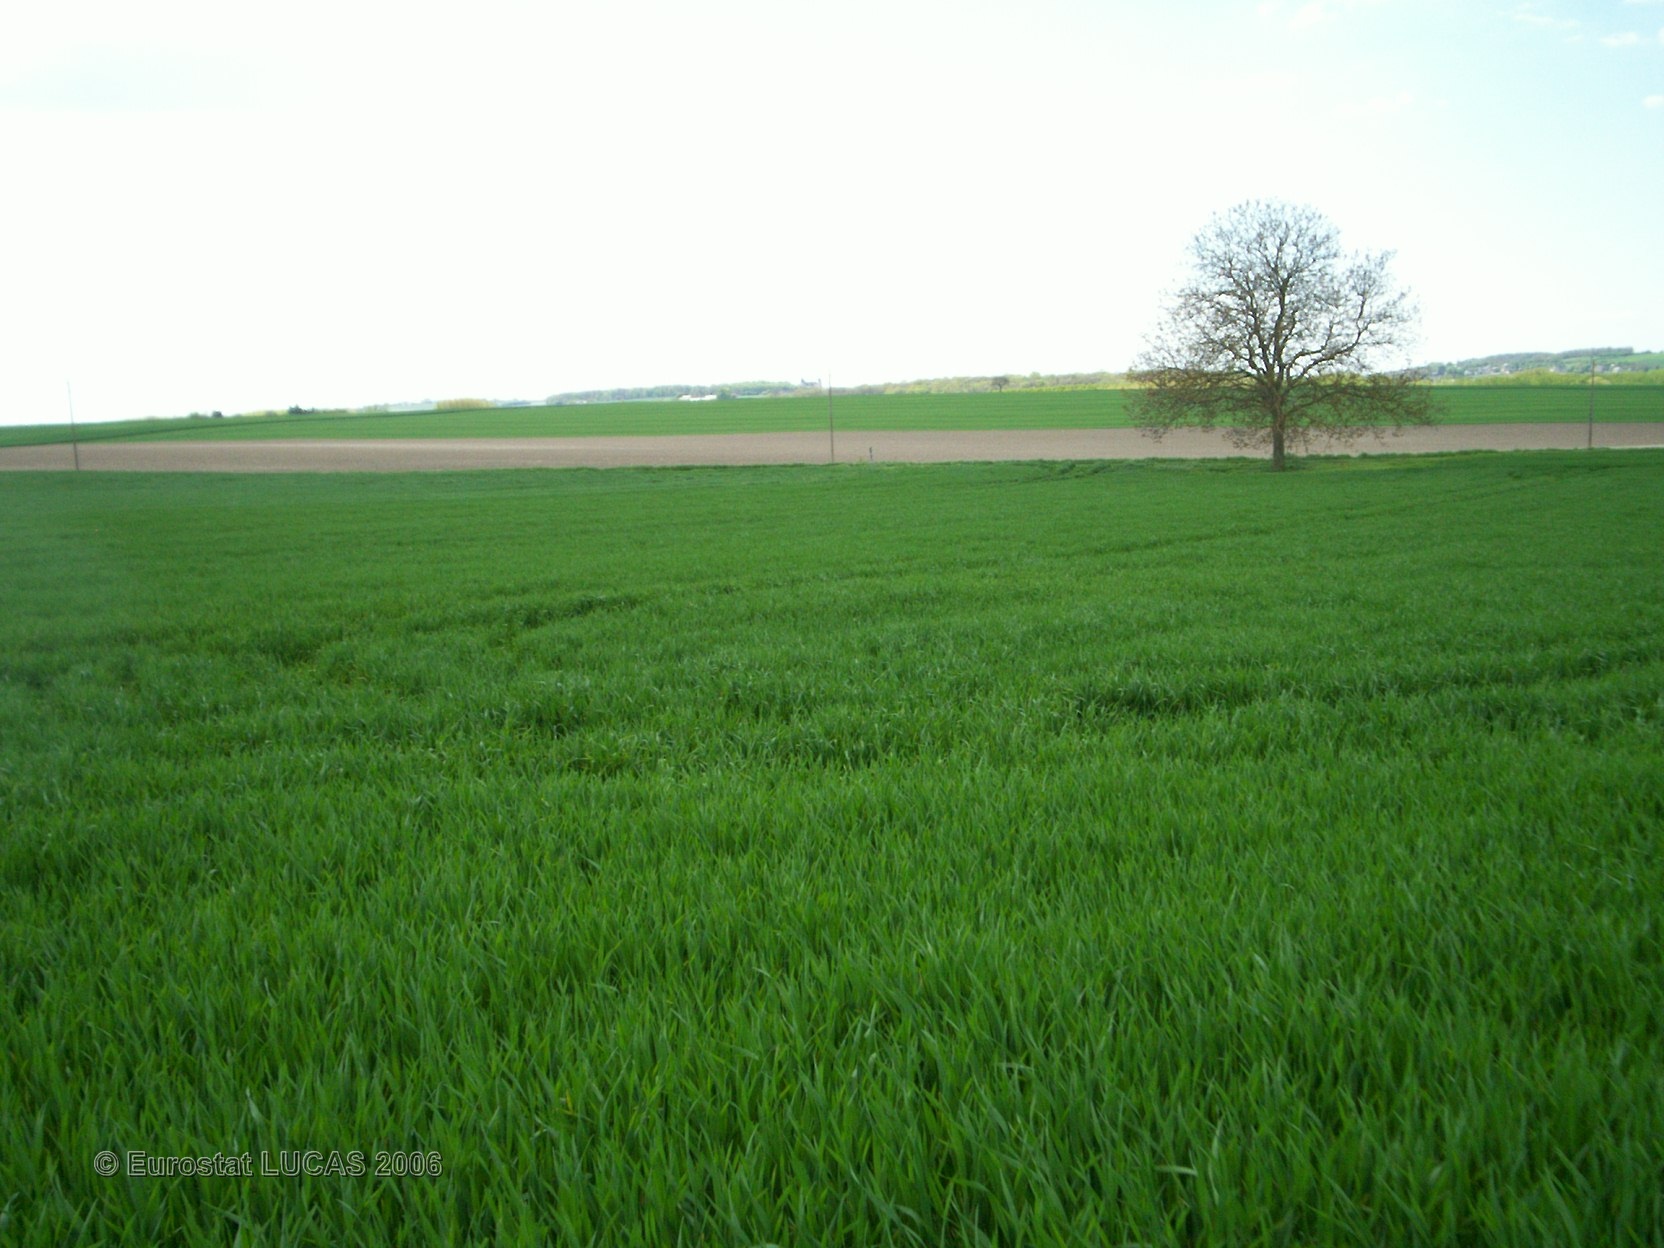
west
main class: Cropland
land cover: Common wheat
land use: Agriculture (excluding fallow land and kitchen gardens)
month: April
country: FR
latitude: 47.1340
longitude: 0.2080
